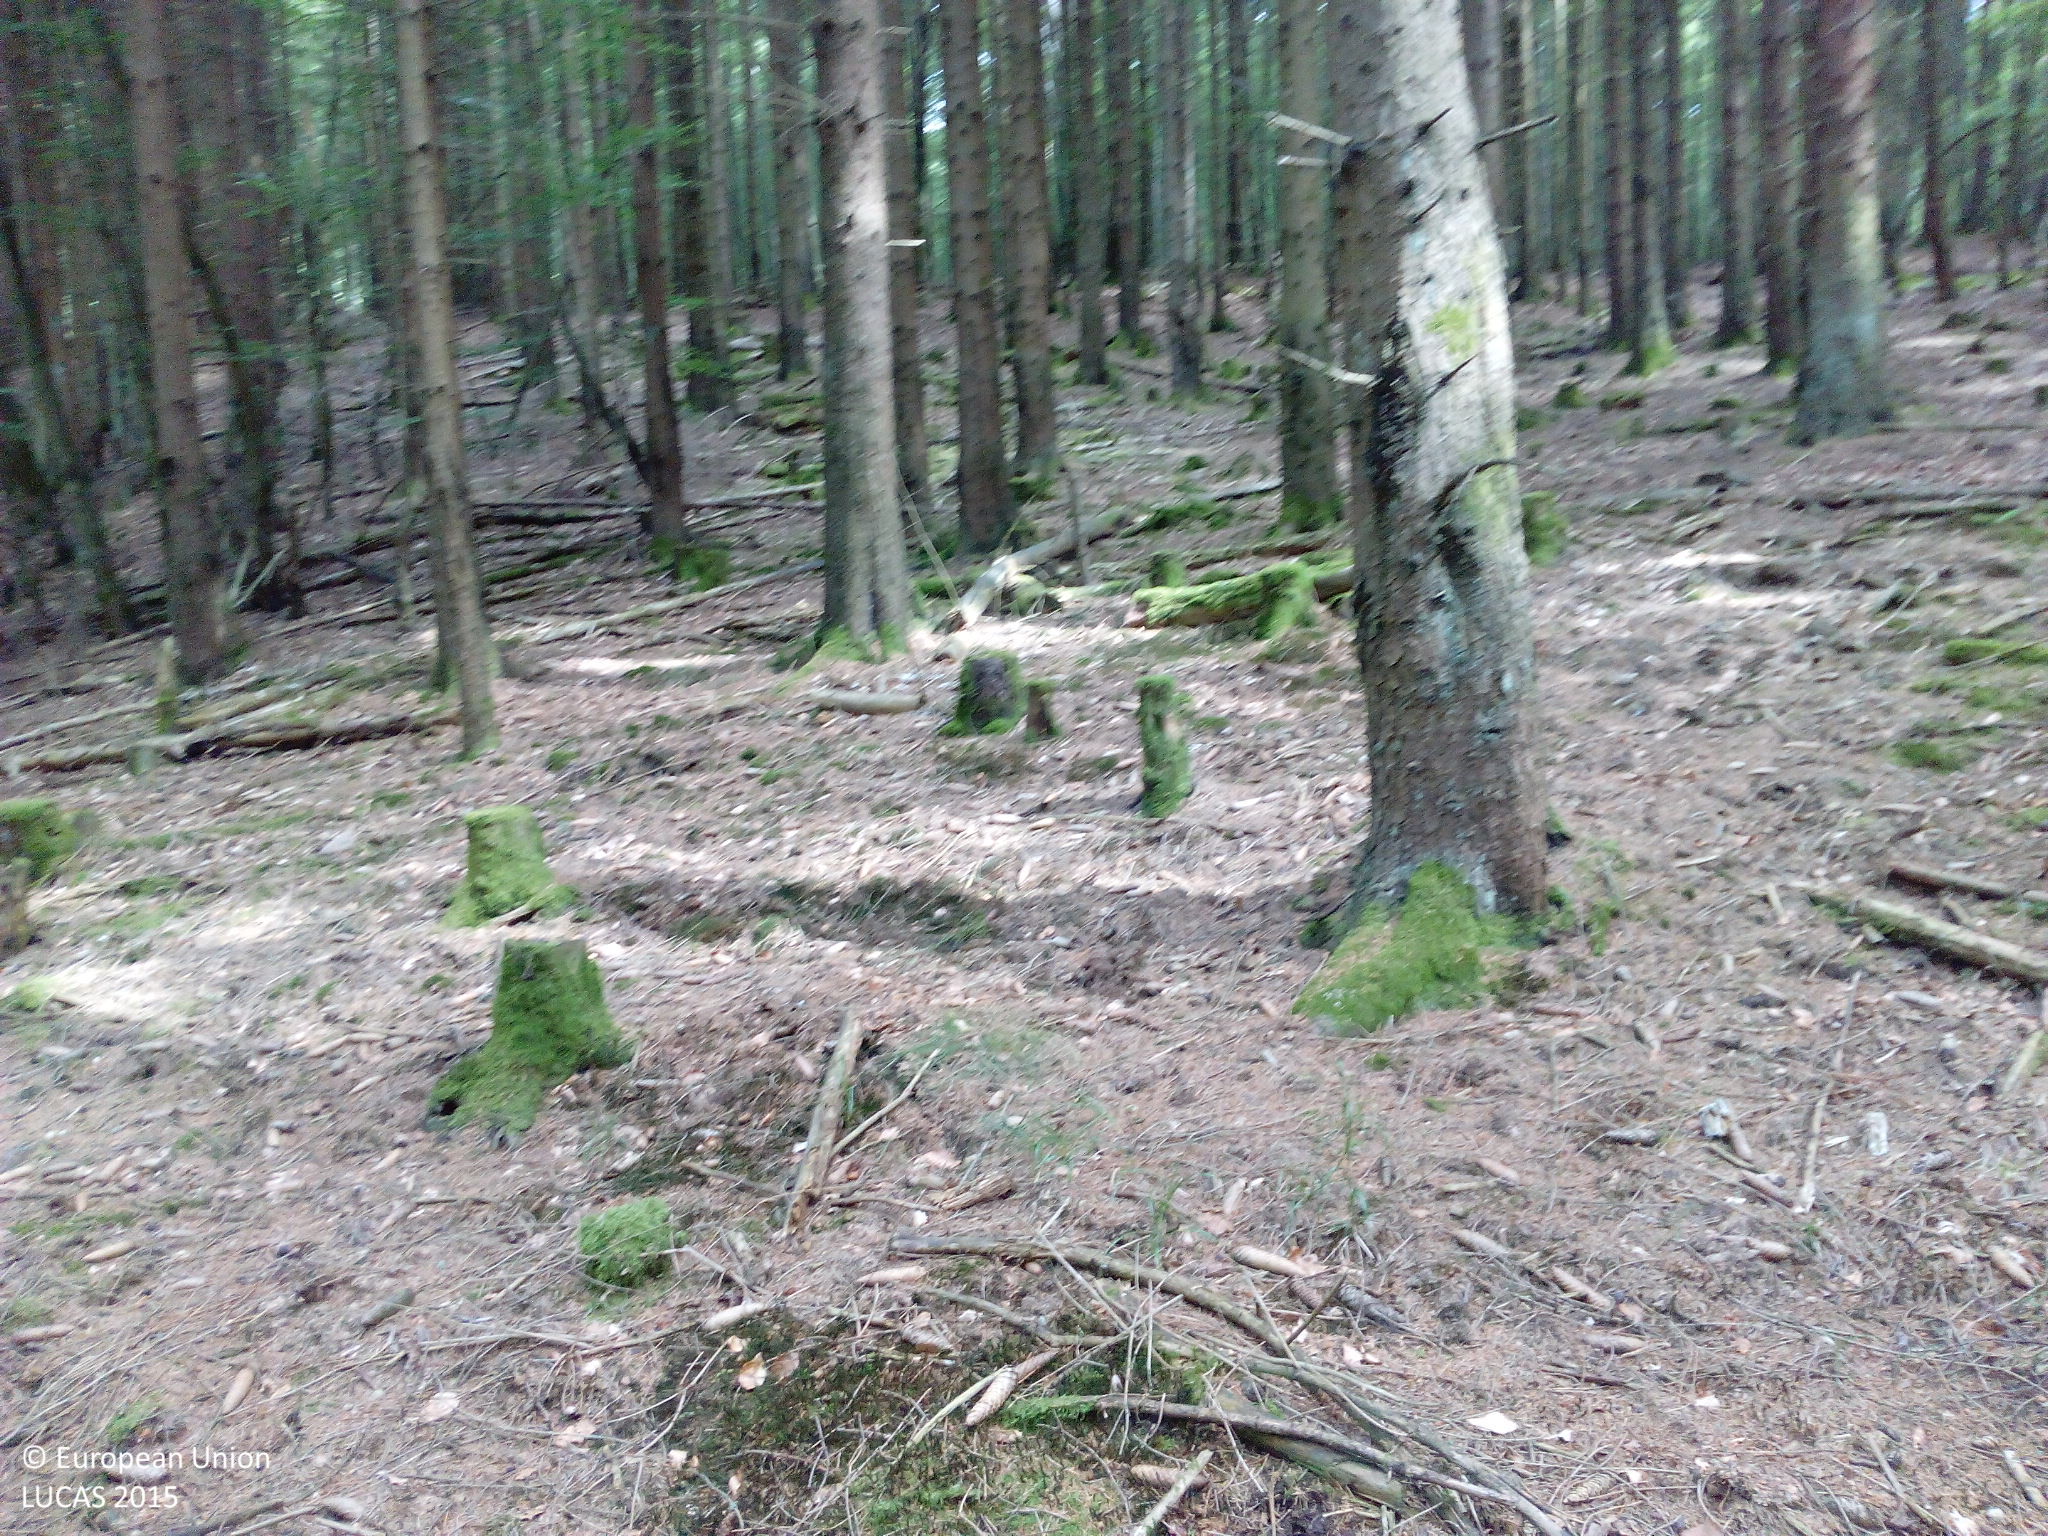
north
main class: Woodland
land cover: Spruce dominated coniferous woodland
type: hemiboreal forest and nemoral coniferous forest and mixed broadleaved-coniferous forest
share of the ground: > 75 %
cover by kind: coniferous forest trees 95 %, broadleaved forest trees 5 %
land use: Forestry
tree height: > 5 m
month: July
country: DE
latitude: 49.7895
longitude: 7.1805
